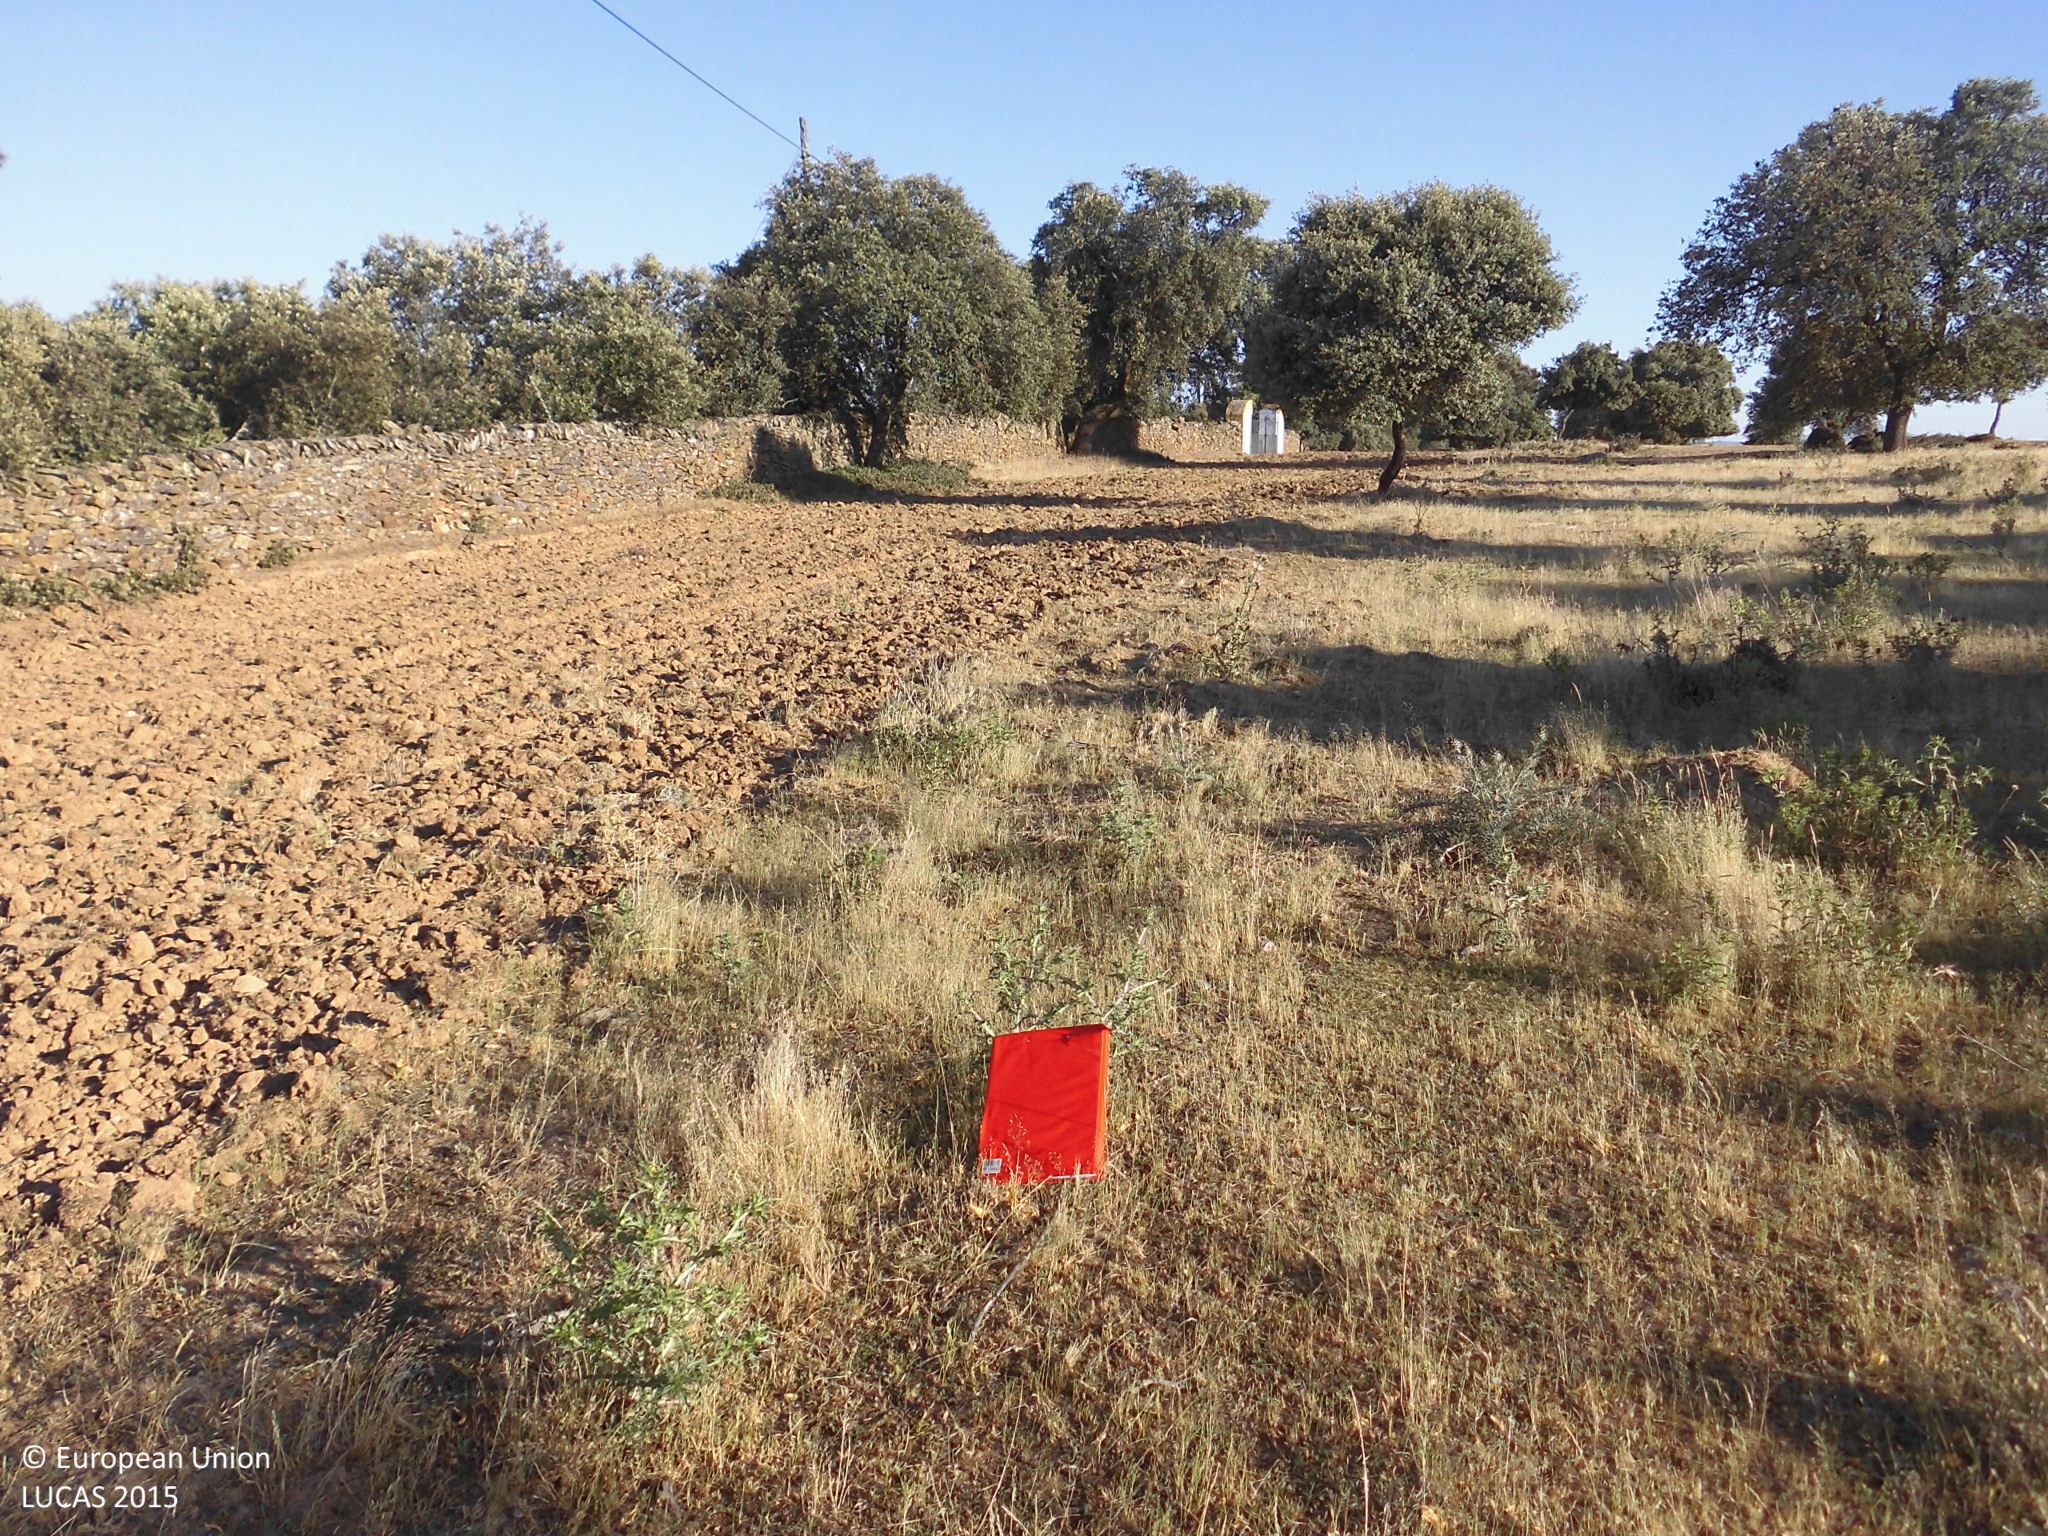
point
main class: Grassland
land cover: Grassland with sparse tree/shrub cover
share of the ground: > 75 %
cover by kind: herbaceous plants 85 %, broadleaved forest trees 5 %, shrubs 5 %, unconsolidated bare surface 5 %
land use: Agriculture (excluding fallow land and kitchen gardens)
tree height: < 5 m
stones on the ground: < 10 %
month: May
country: ES
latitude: 39.4255
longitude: -5.9859
